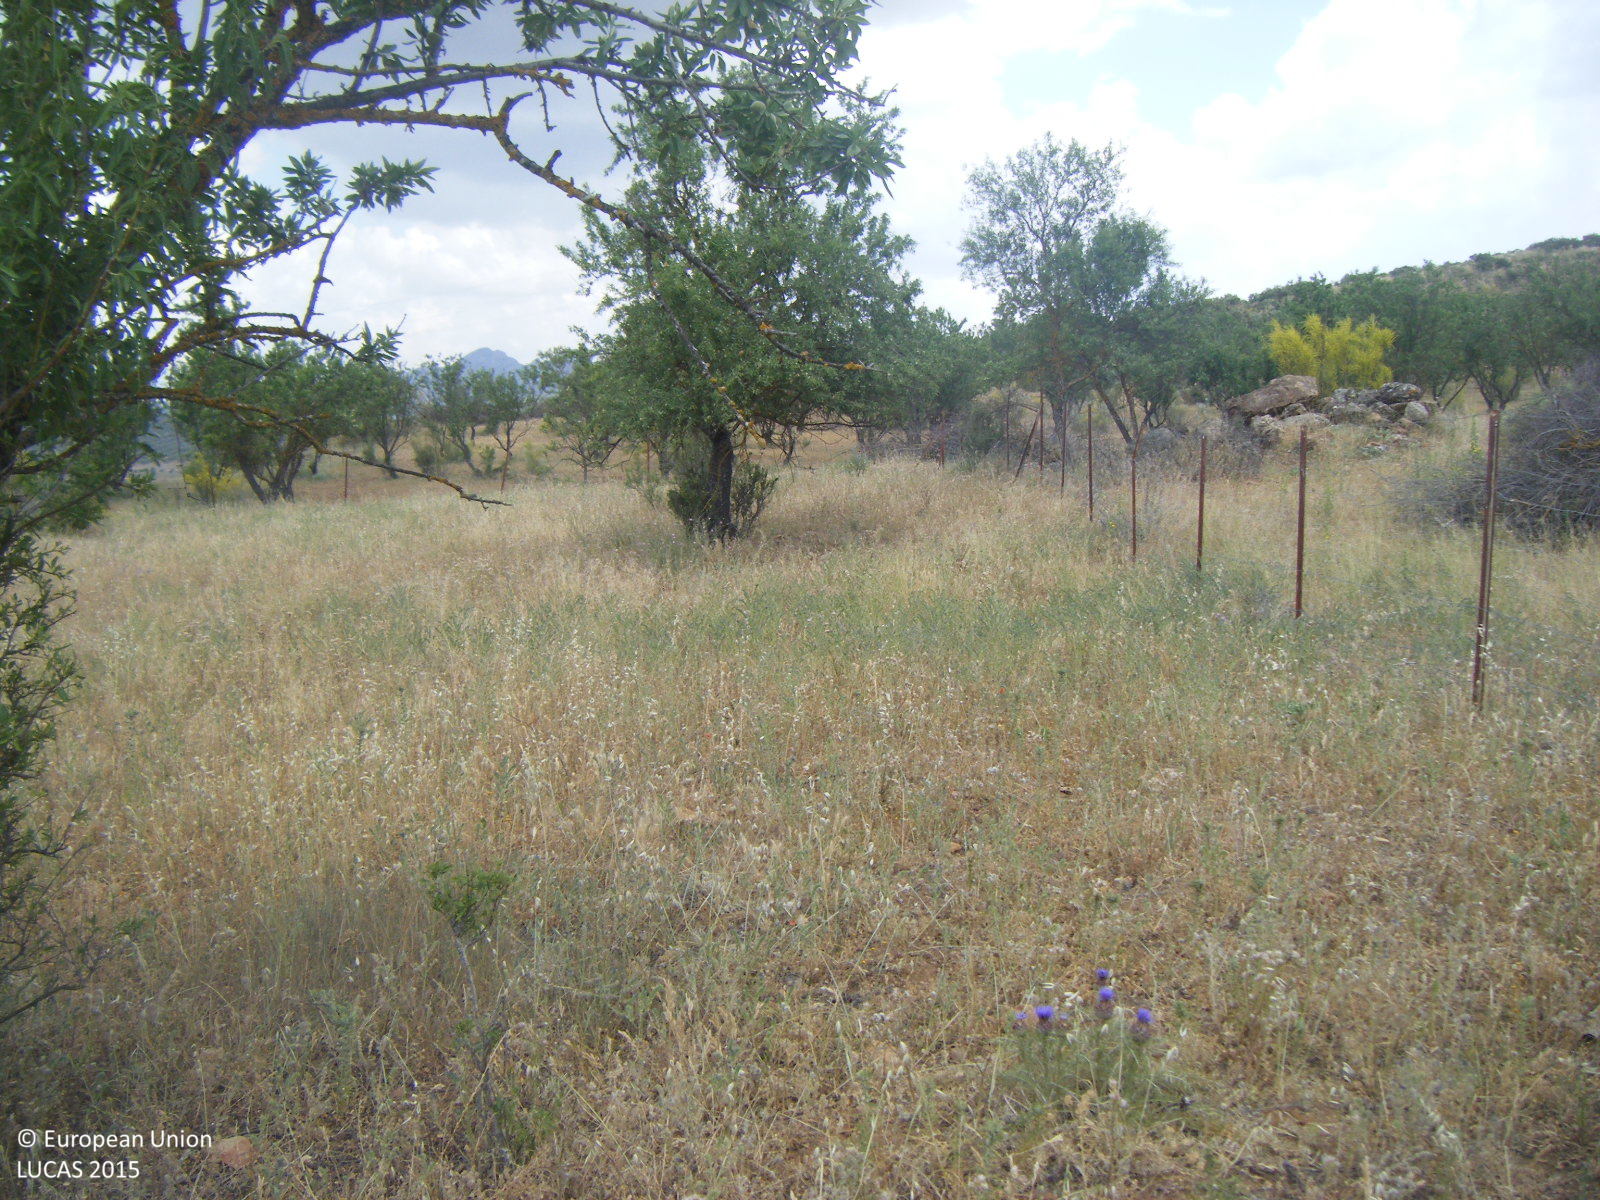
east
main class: Cropland
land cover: Nuts trees
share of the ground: 10 - 25 %
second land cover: Spontaneously vegetated surfaces
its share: > 75 %
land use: Agriculture (excluding fallow land and kitchen gardens)
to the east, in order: Nuts trees; Spontaneously vegetated surfaces; Shrubland without tree cover
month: May
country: ES
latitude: 37.0754
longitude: -4.4730
